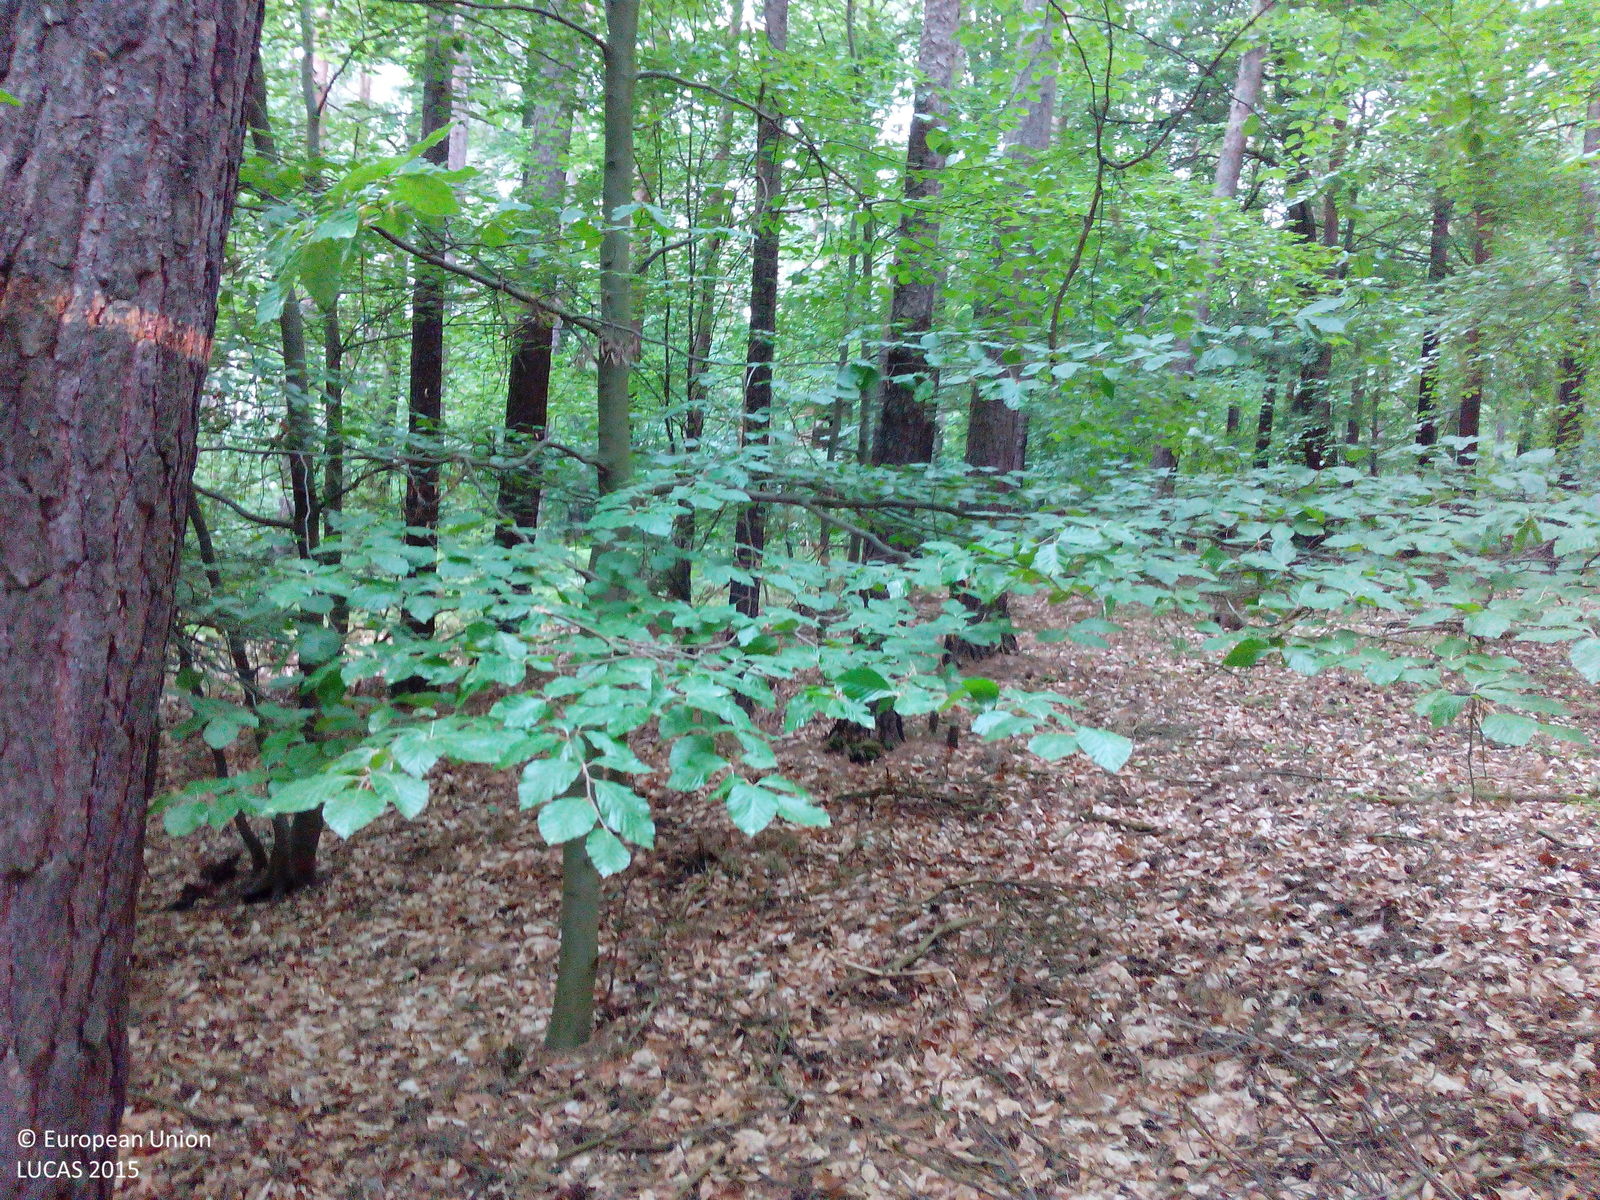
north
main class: Woodland
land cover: Other mixed woodland
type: hemiboreal forest and nemoral coniferous forest and mixed broadleaved-coniferous forest
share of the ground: > 75 %
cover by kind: coniferous forest trees 70 %, broadleaved forest trees 25 %, unconsolidated bare surface 5 %
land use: Forestry
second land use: Amenities, museums, leisure
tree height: > 5 m
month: June
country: DE
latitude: 50.6964
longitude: 11.4579
